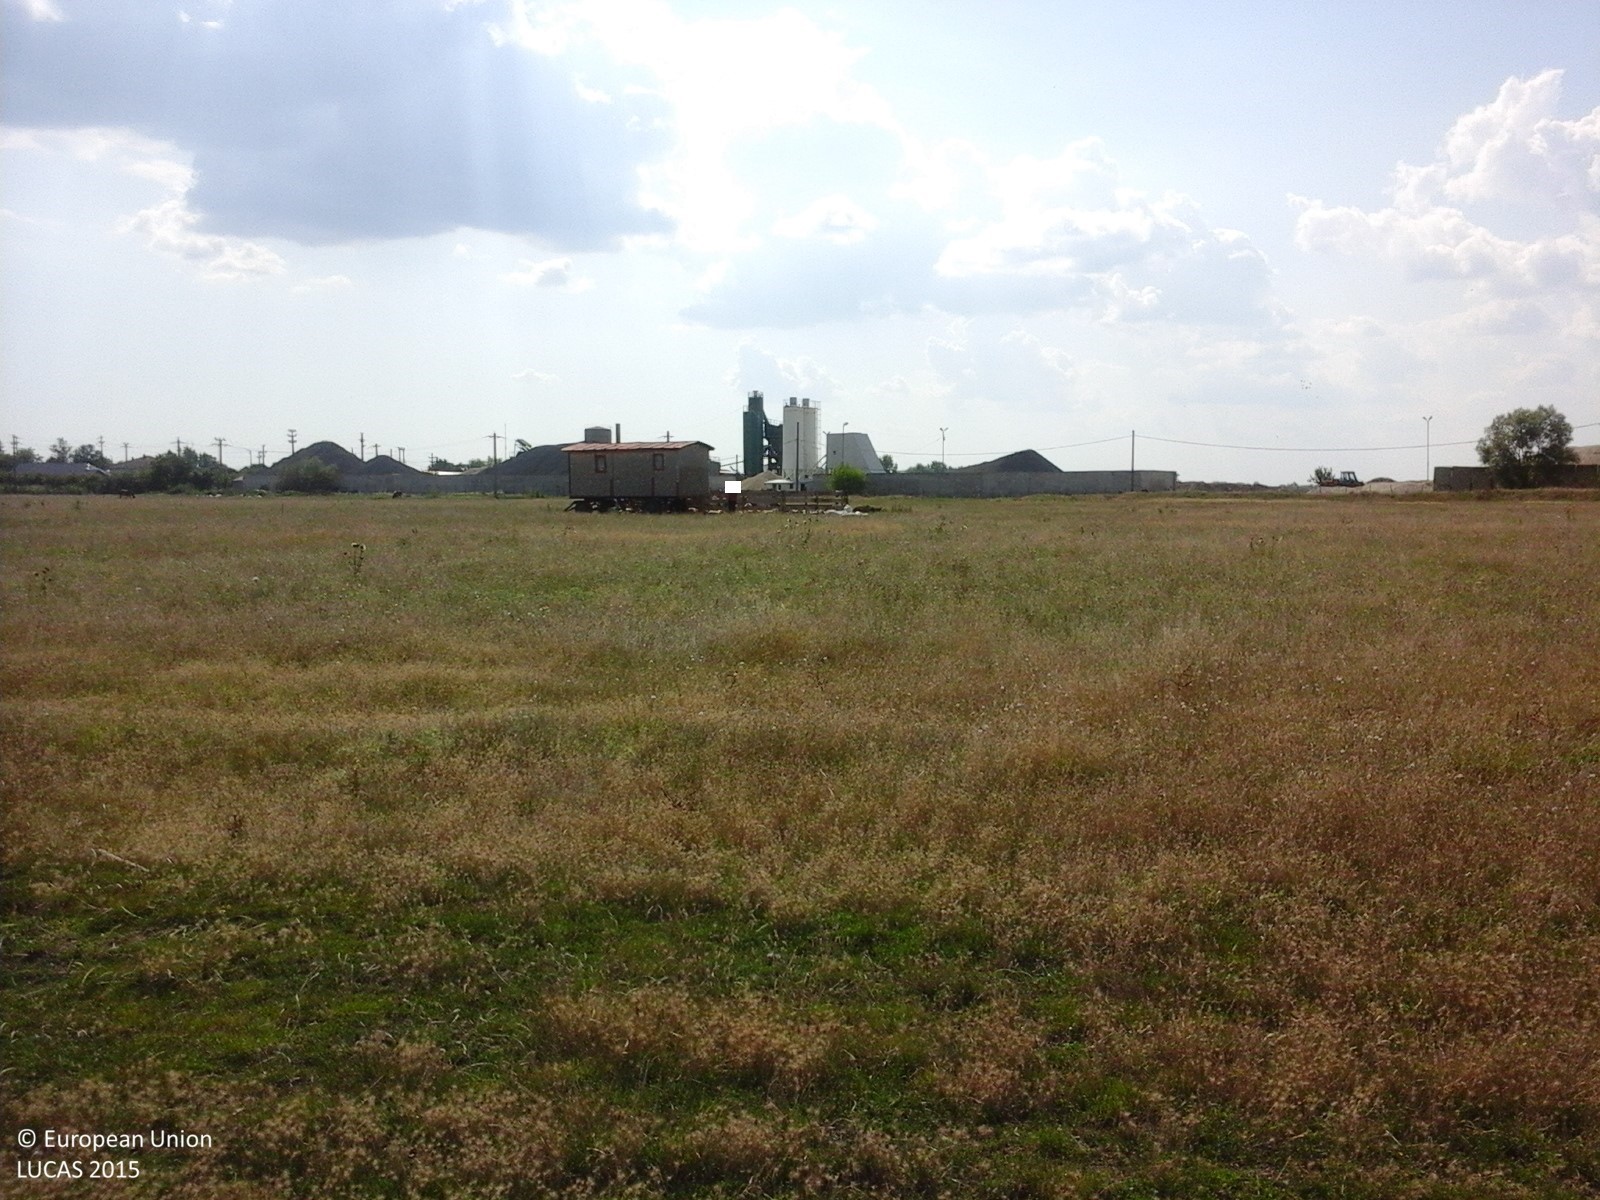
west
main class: Grassland
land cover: Grassland without tree/shrub cover
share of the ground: > 75 %
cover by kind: herbaceous plants 100 %
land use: Agriculture (excluding fallow land and kitchen gardens)
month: July
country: RO
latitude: 43.9986
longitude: 25.2838
